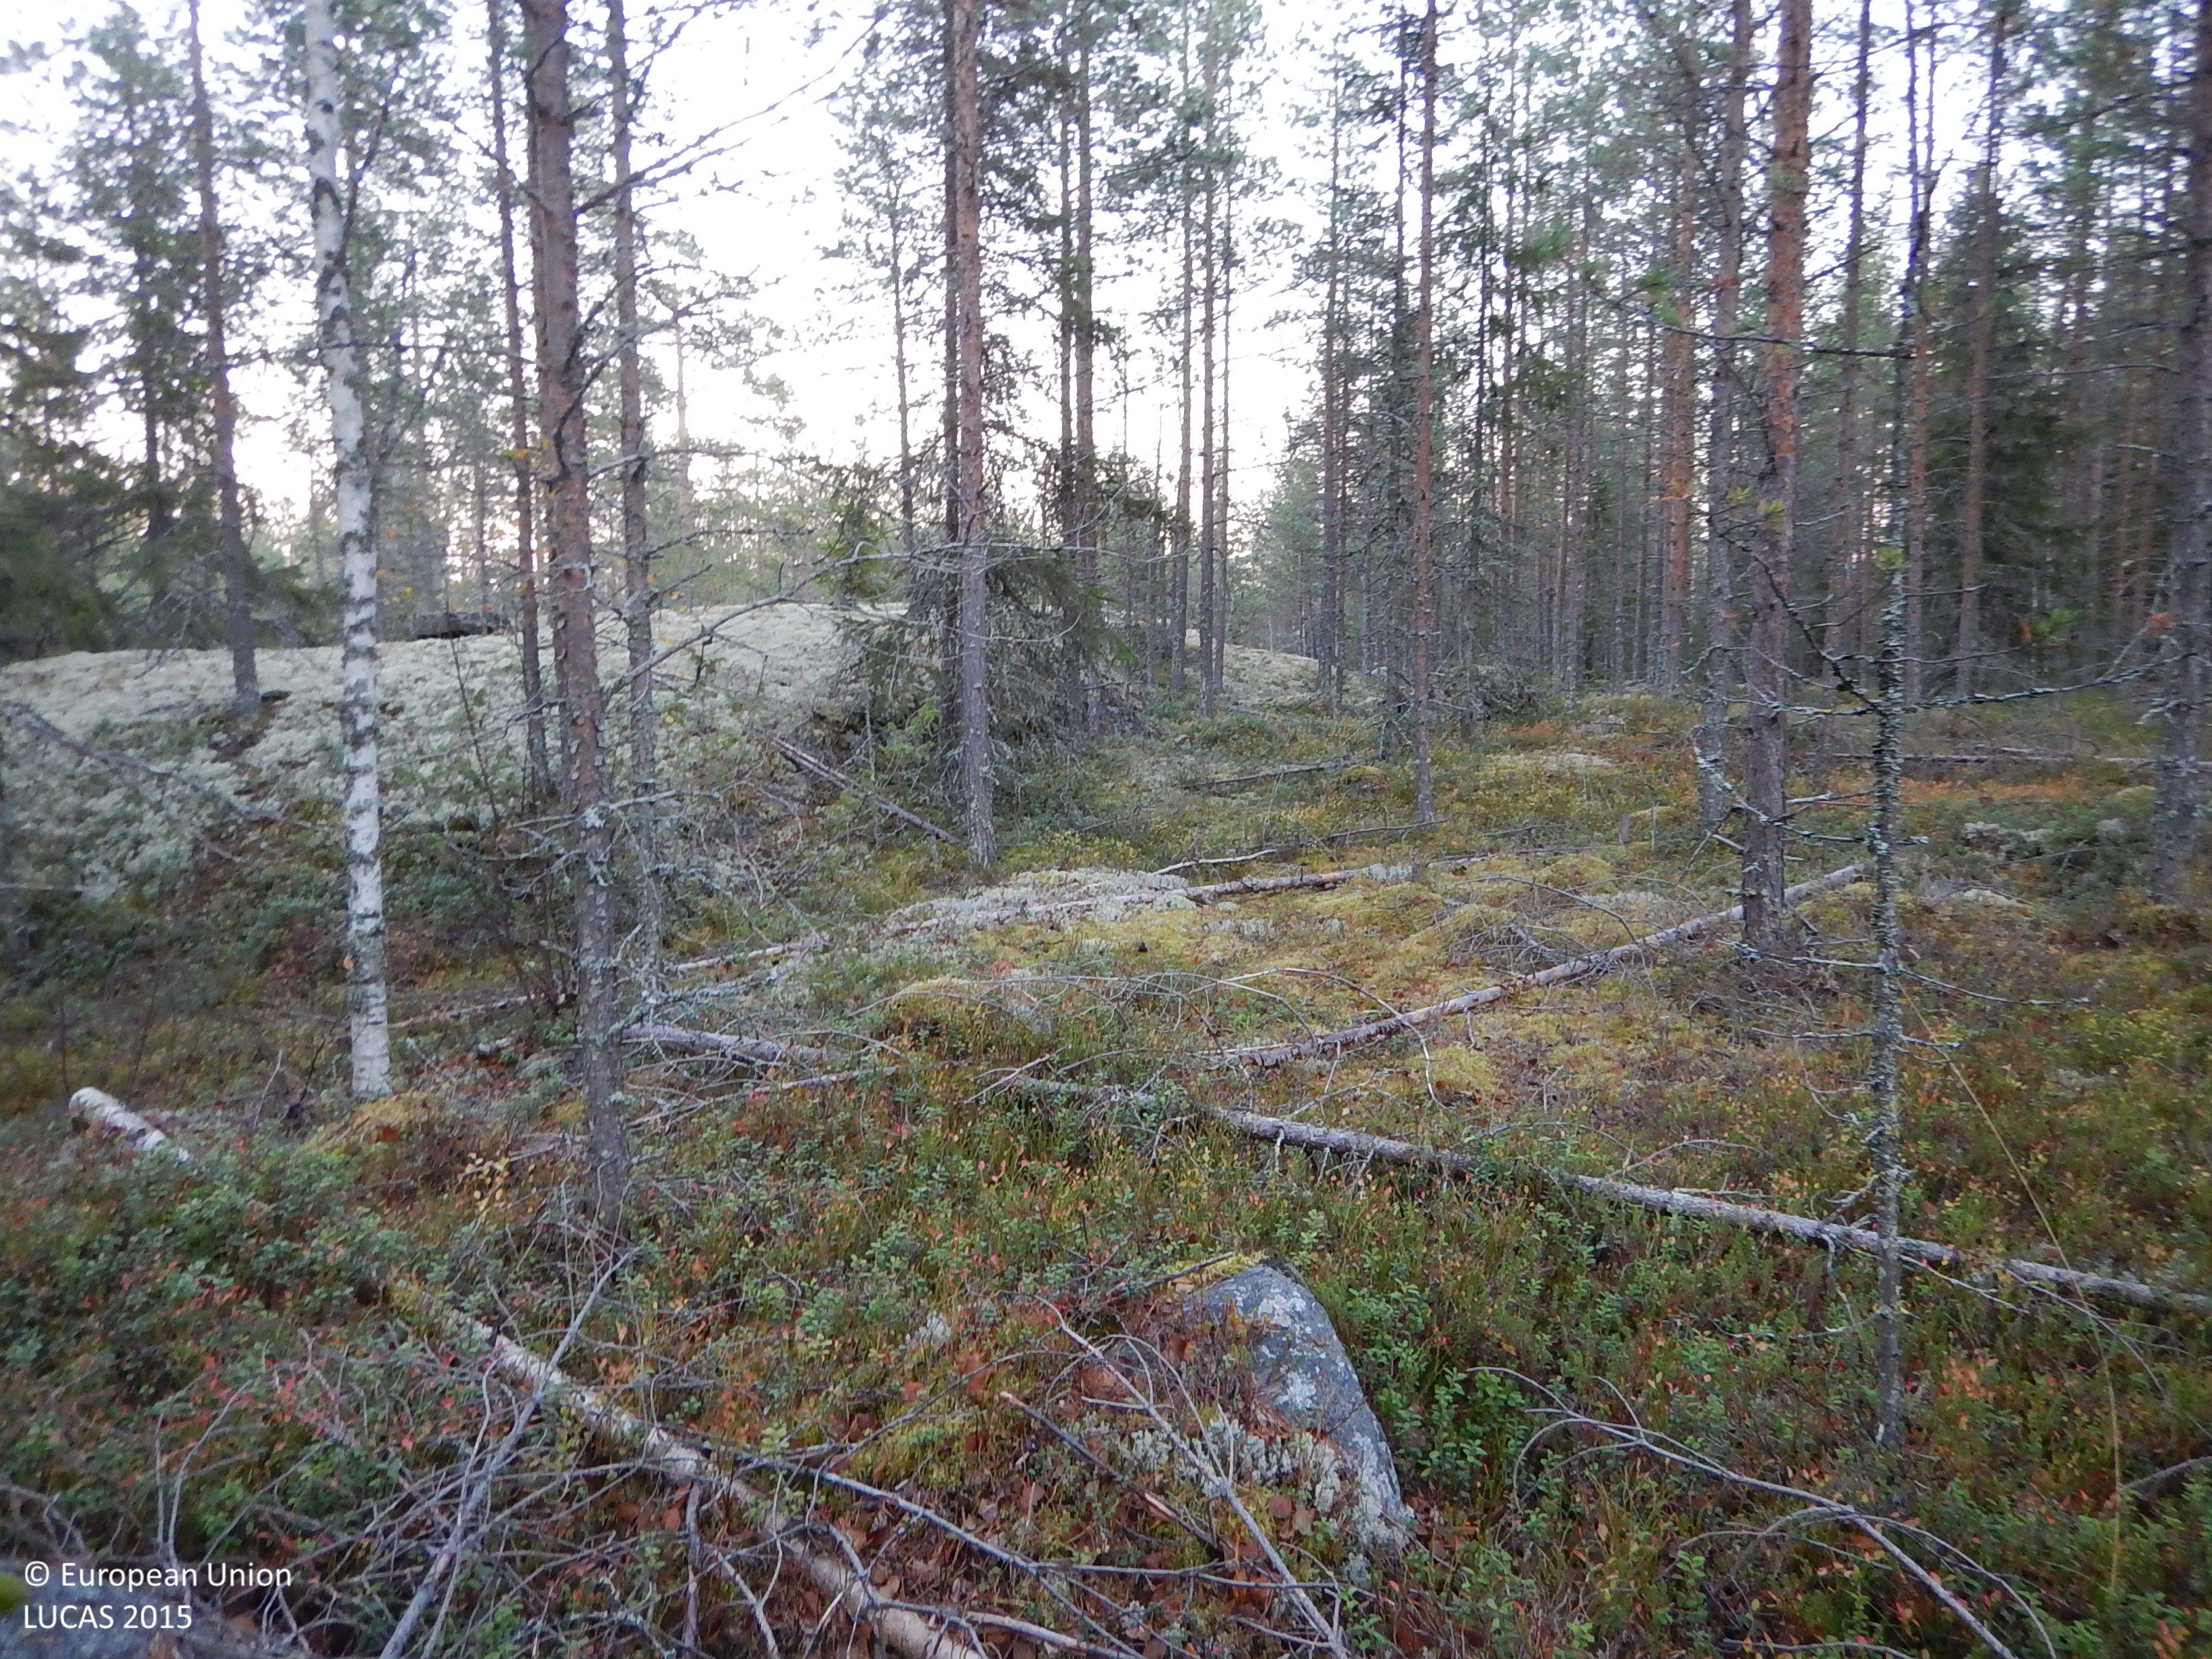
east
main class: Woodland
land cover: Pine dominated coniferous woodland
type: boreal forest
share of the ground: 50 - 75 %
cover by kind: coniferous forest trees 45 %, shrubs 20 %, lichens and mosses 20 %, broadleaved forest trees 5 %, herbaceous plants 5 %, consolidated bare surface 5 %
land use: Forestry
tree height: > 5 m
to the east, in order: Pine dominated coniferous woodland; Other coniferous woodland; Electric lines; Grass margins; Paved roads, cycling and walking lanes; Grass margins; Other mixed woodland; Other coniferous woodland
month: October
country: SE
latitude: 64.9317
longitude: 20.9543
